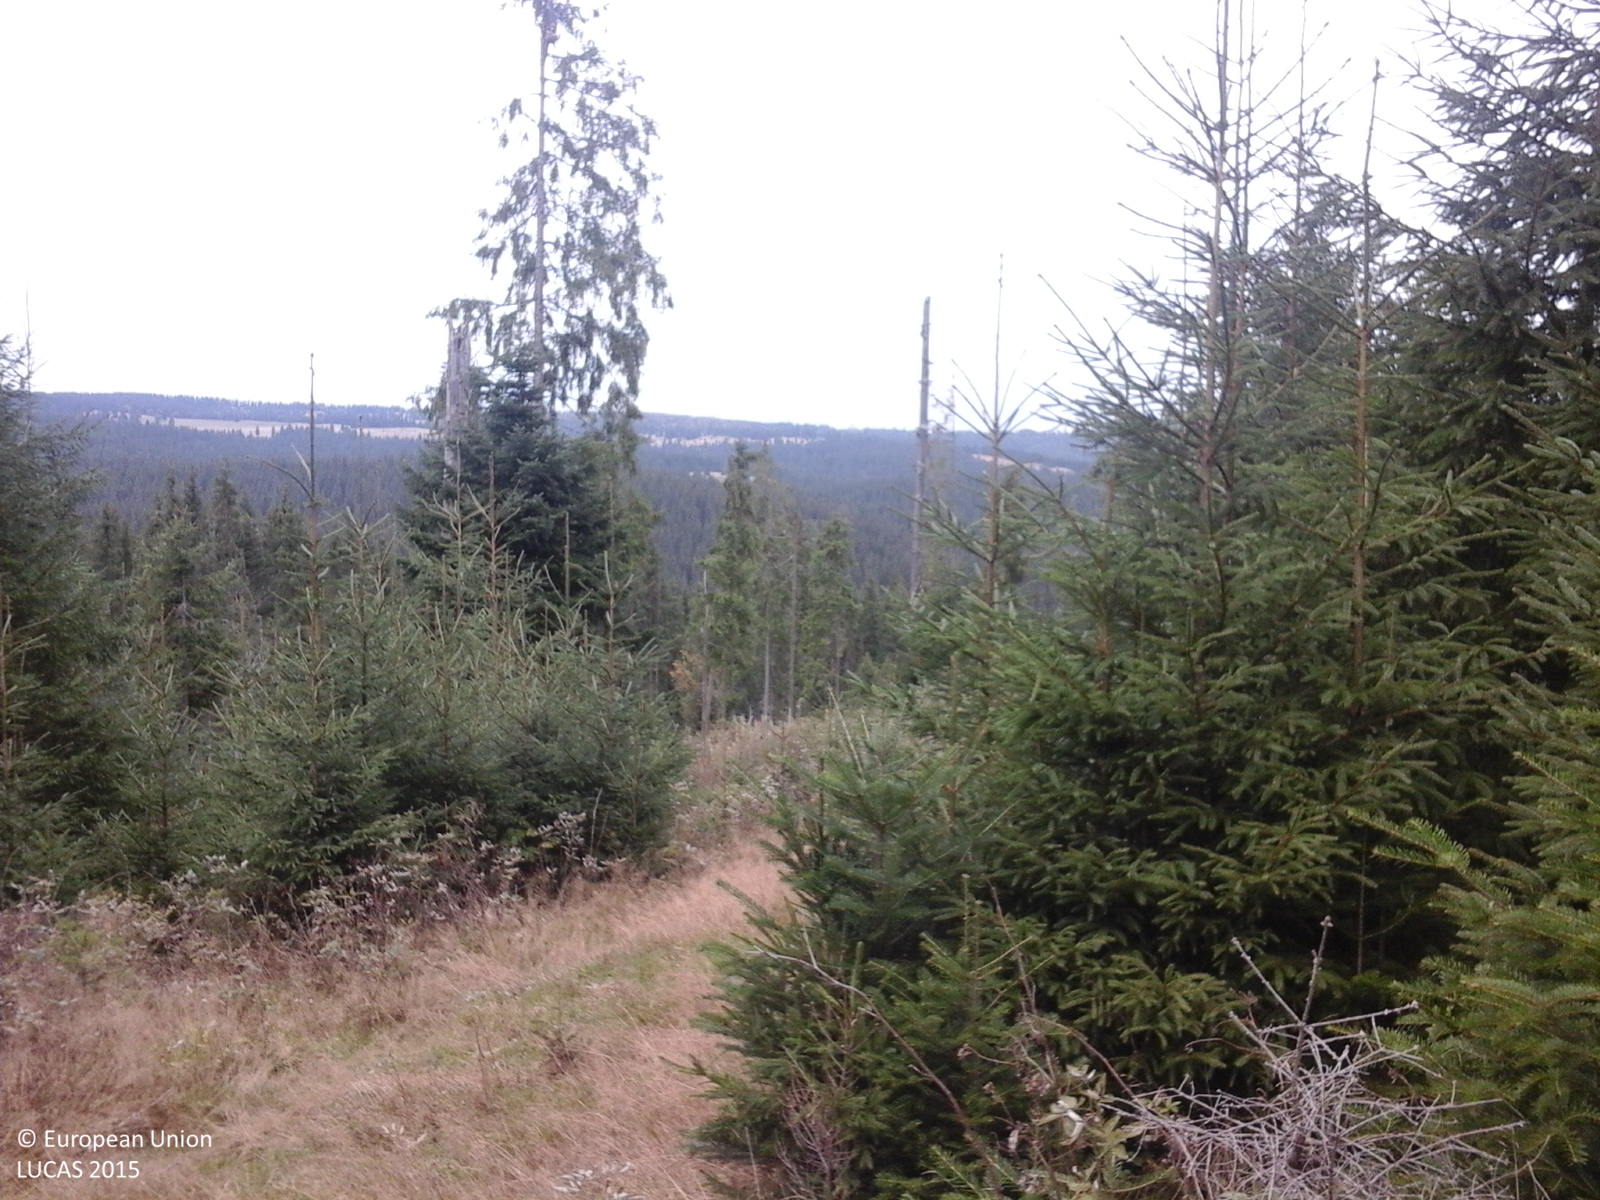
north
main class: Woodland
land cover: Spruce dominated coniferous woodland
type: alpine coniferous forest
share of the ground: > 75 %
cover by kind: coniferous forest trees 100 %
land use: Forestry
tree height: > 5 m
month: September
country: RO
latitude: 46.6417
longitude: 22.9006
